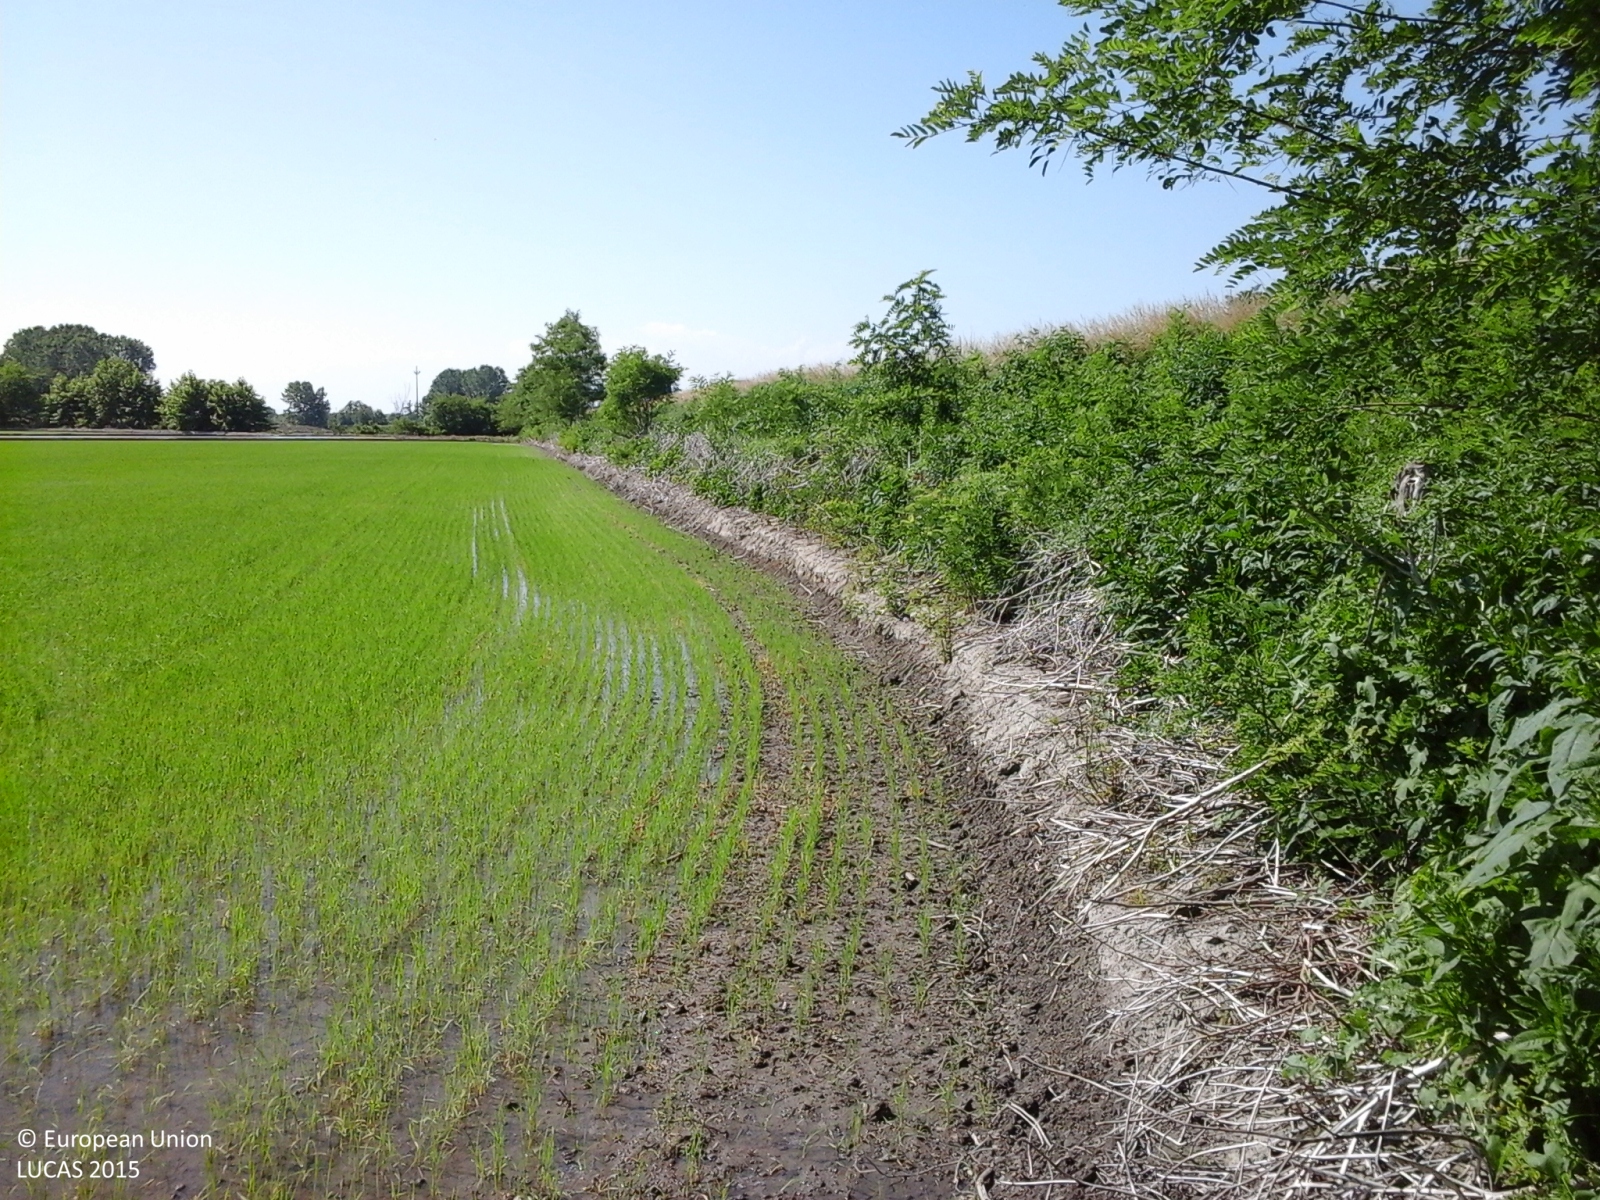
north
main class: Cropland
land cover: Rice
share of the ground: 50 - 75 %
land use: Agriculture (excluding fallow land and kitchen gardens)
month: May
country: IT
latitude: 45.2585
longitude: 8.4353
